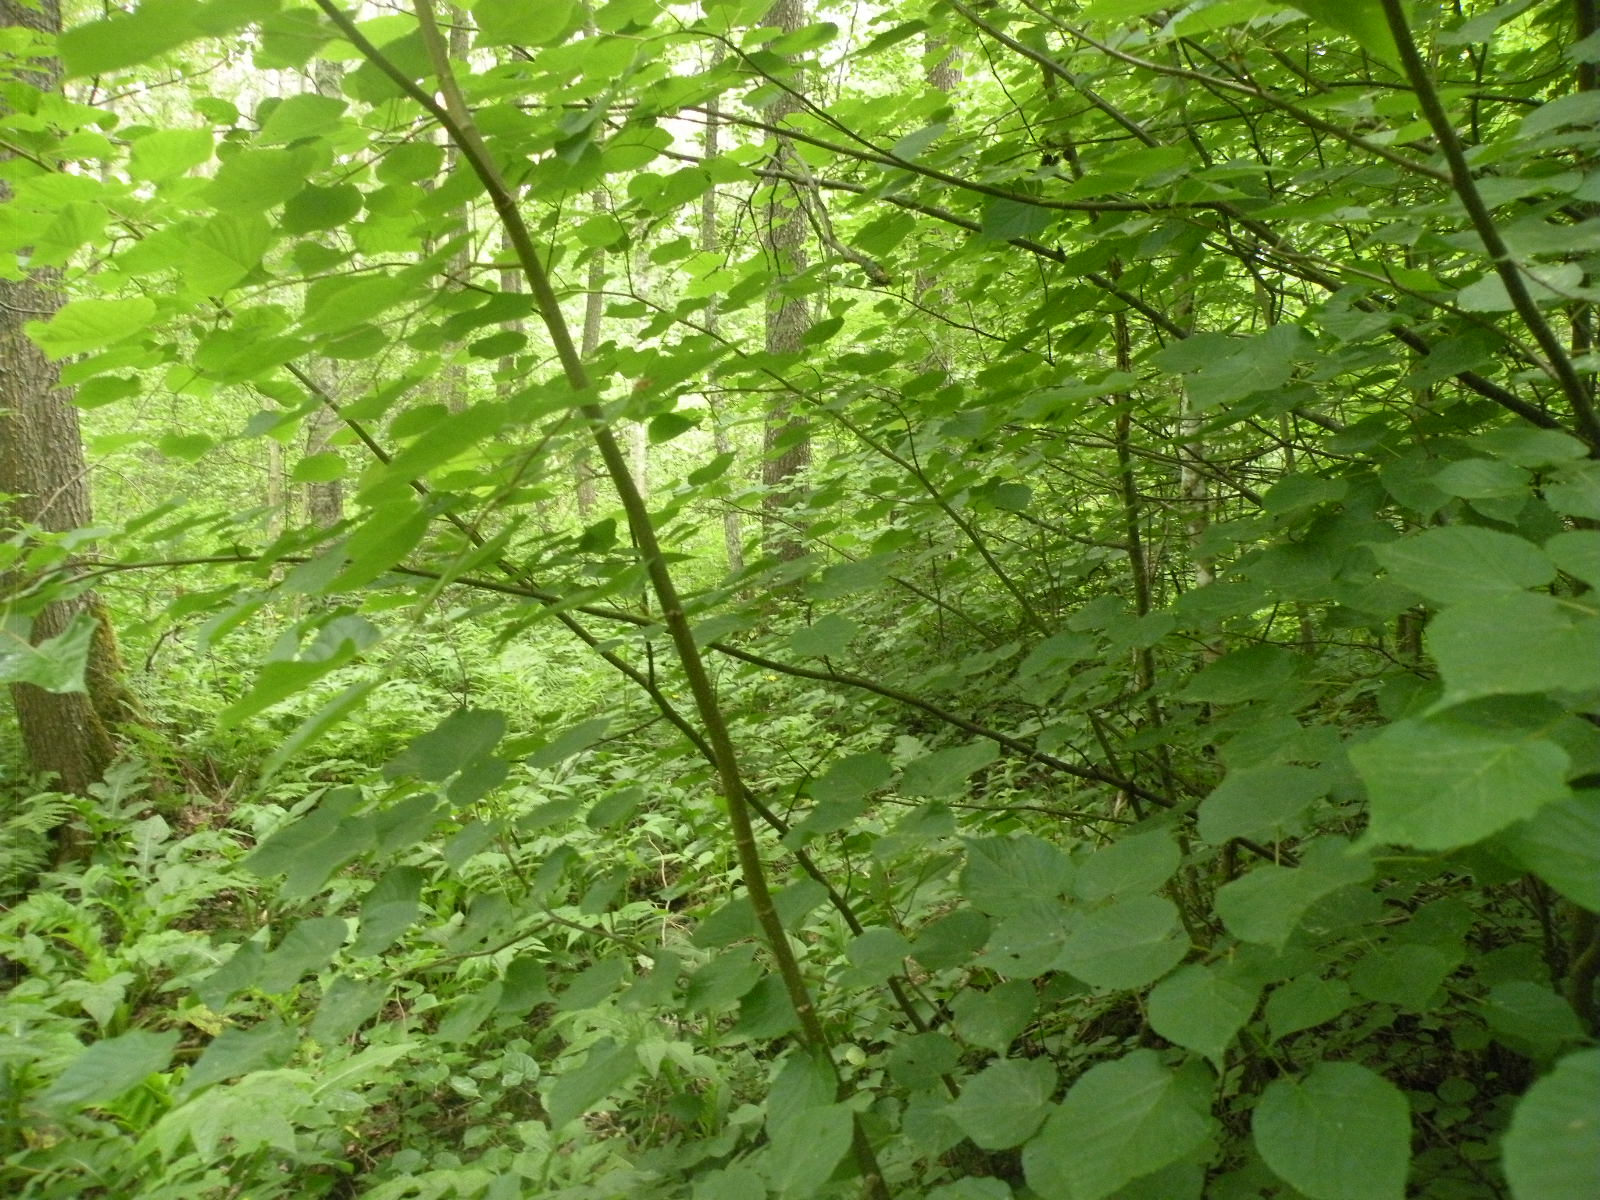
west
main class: Woodland
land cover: Broadleaved woodland
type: non-riverine alder, birch or aspen forest
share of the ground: > 75 %
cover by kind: broadleaved forest trees 90 %, shrubs 5 %, herbaceous plants 5 %
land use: Forestry
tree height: > 5 m
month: June
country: LV
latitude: 55.9227
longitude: 27.0172
